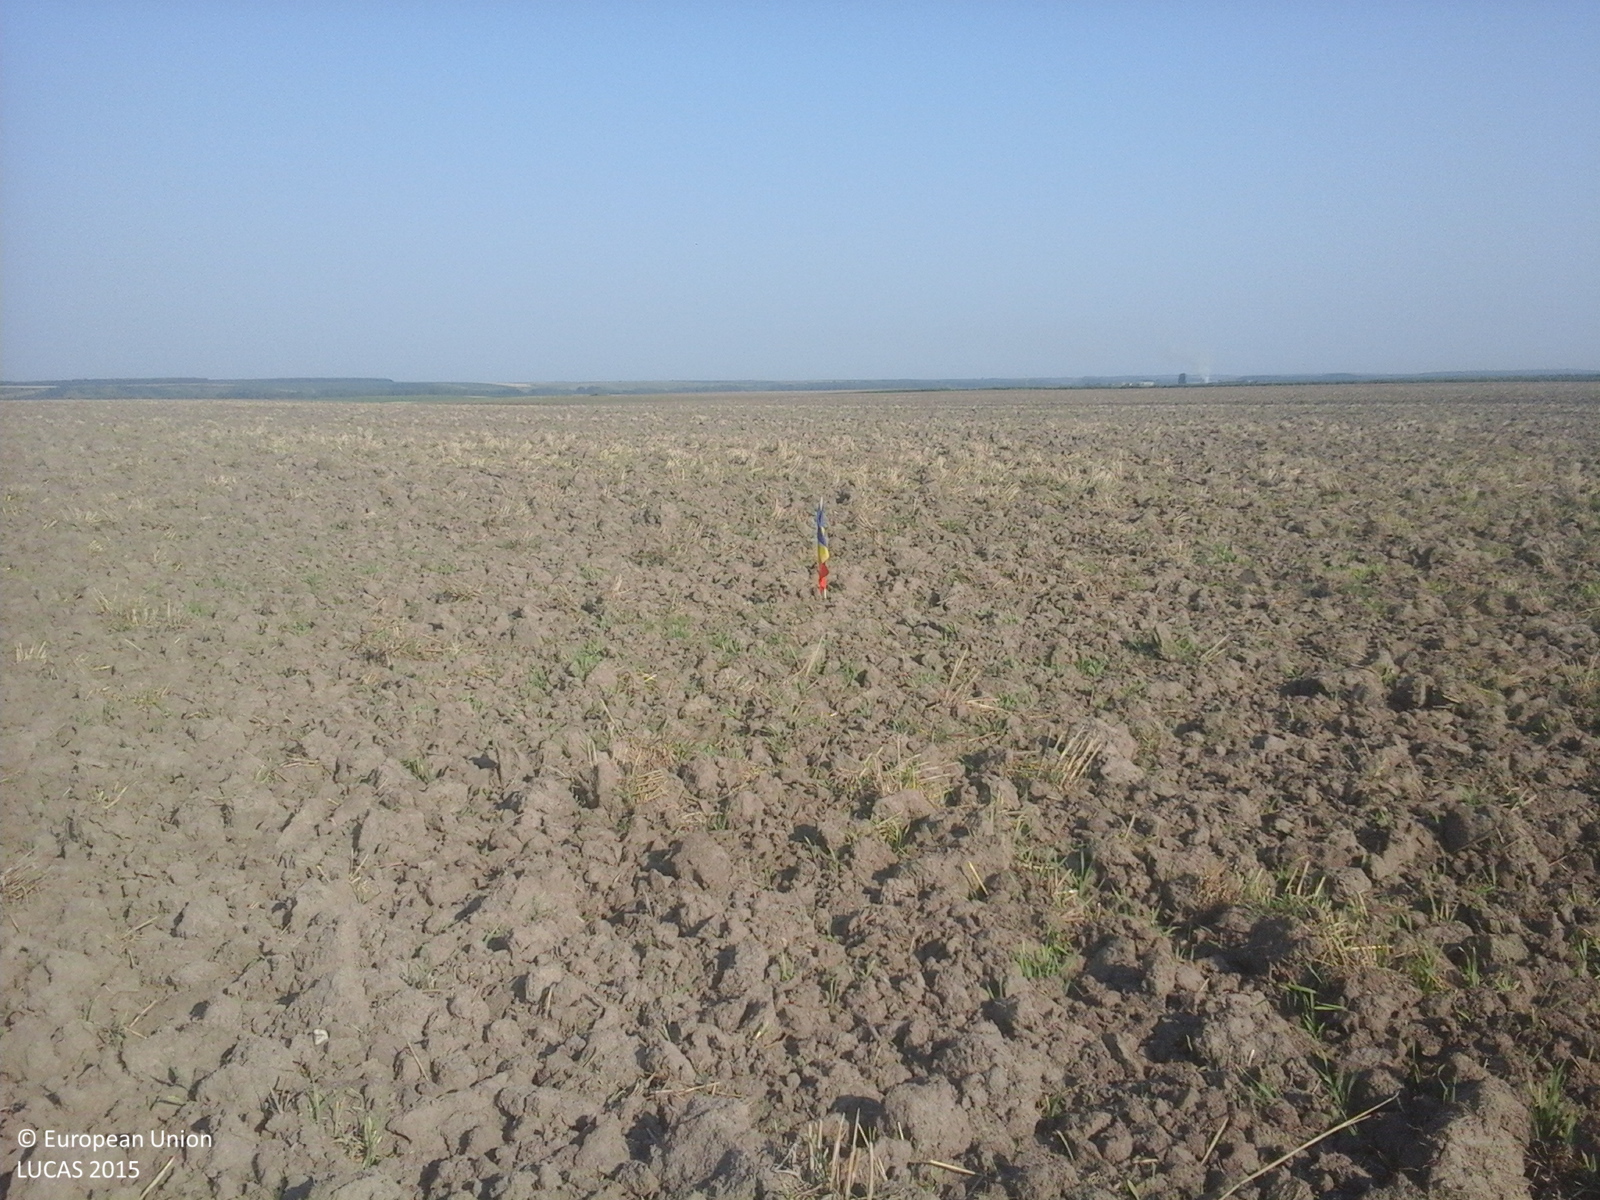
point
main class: Cropland
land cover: Rye
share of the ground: < 10 %
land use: Agriculture (excluding fallow land and kitchen gardens)
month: July
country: RO
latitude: 44.4977
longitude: 24.7527
